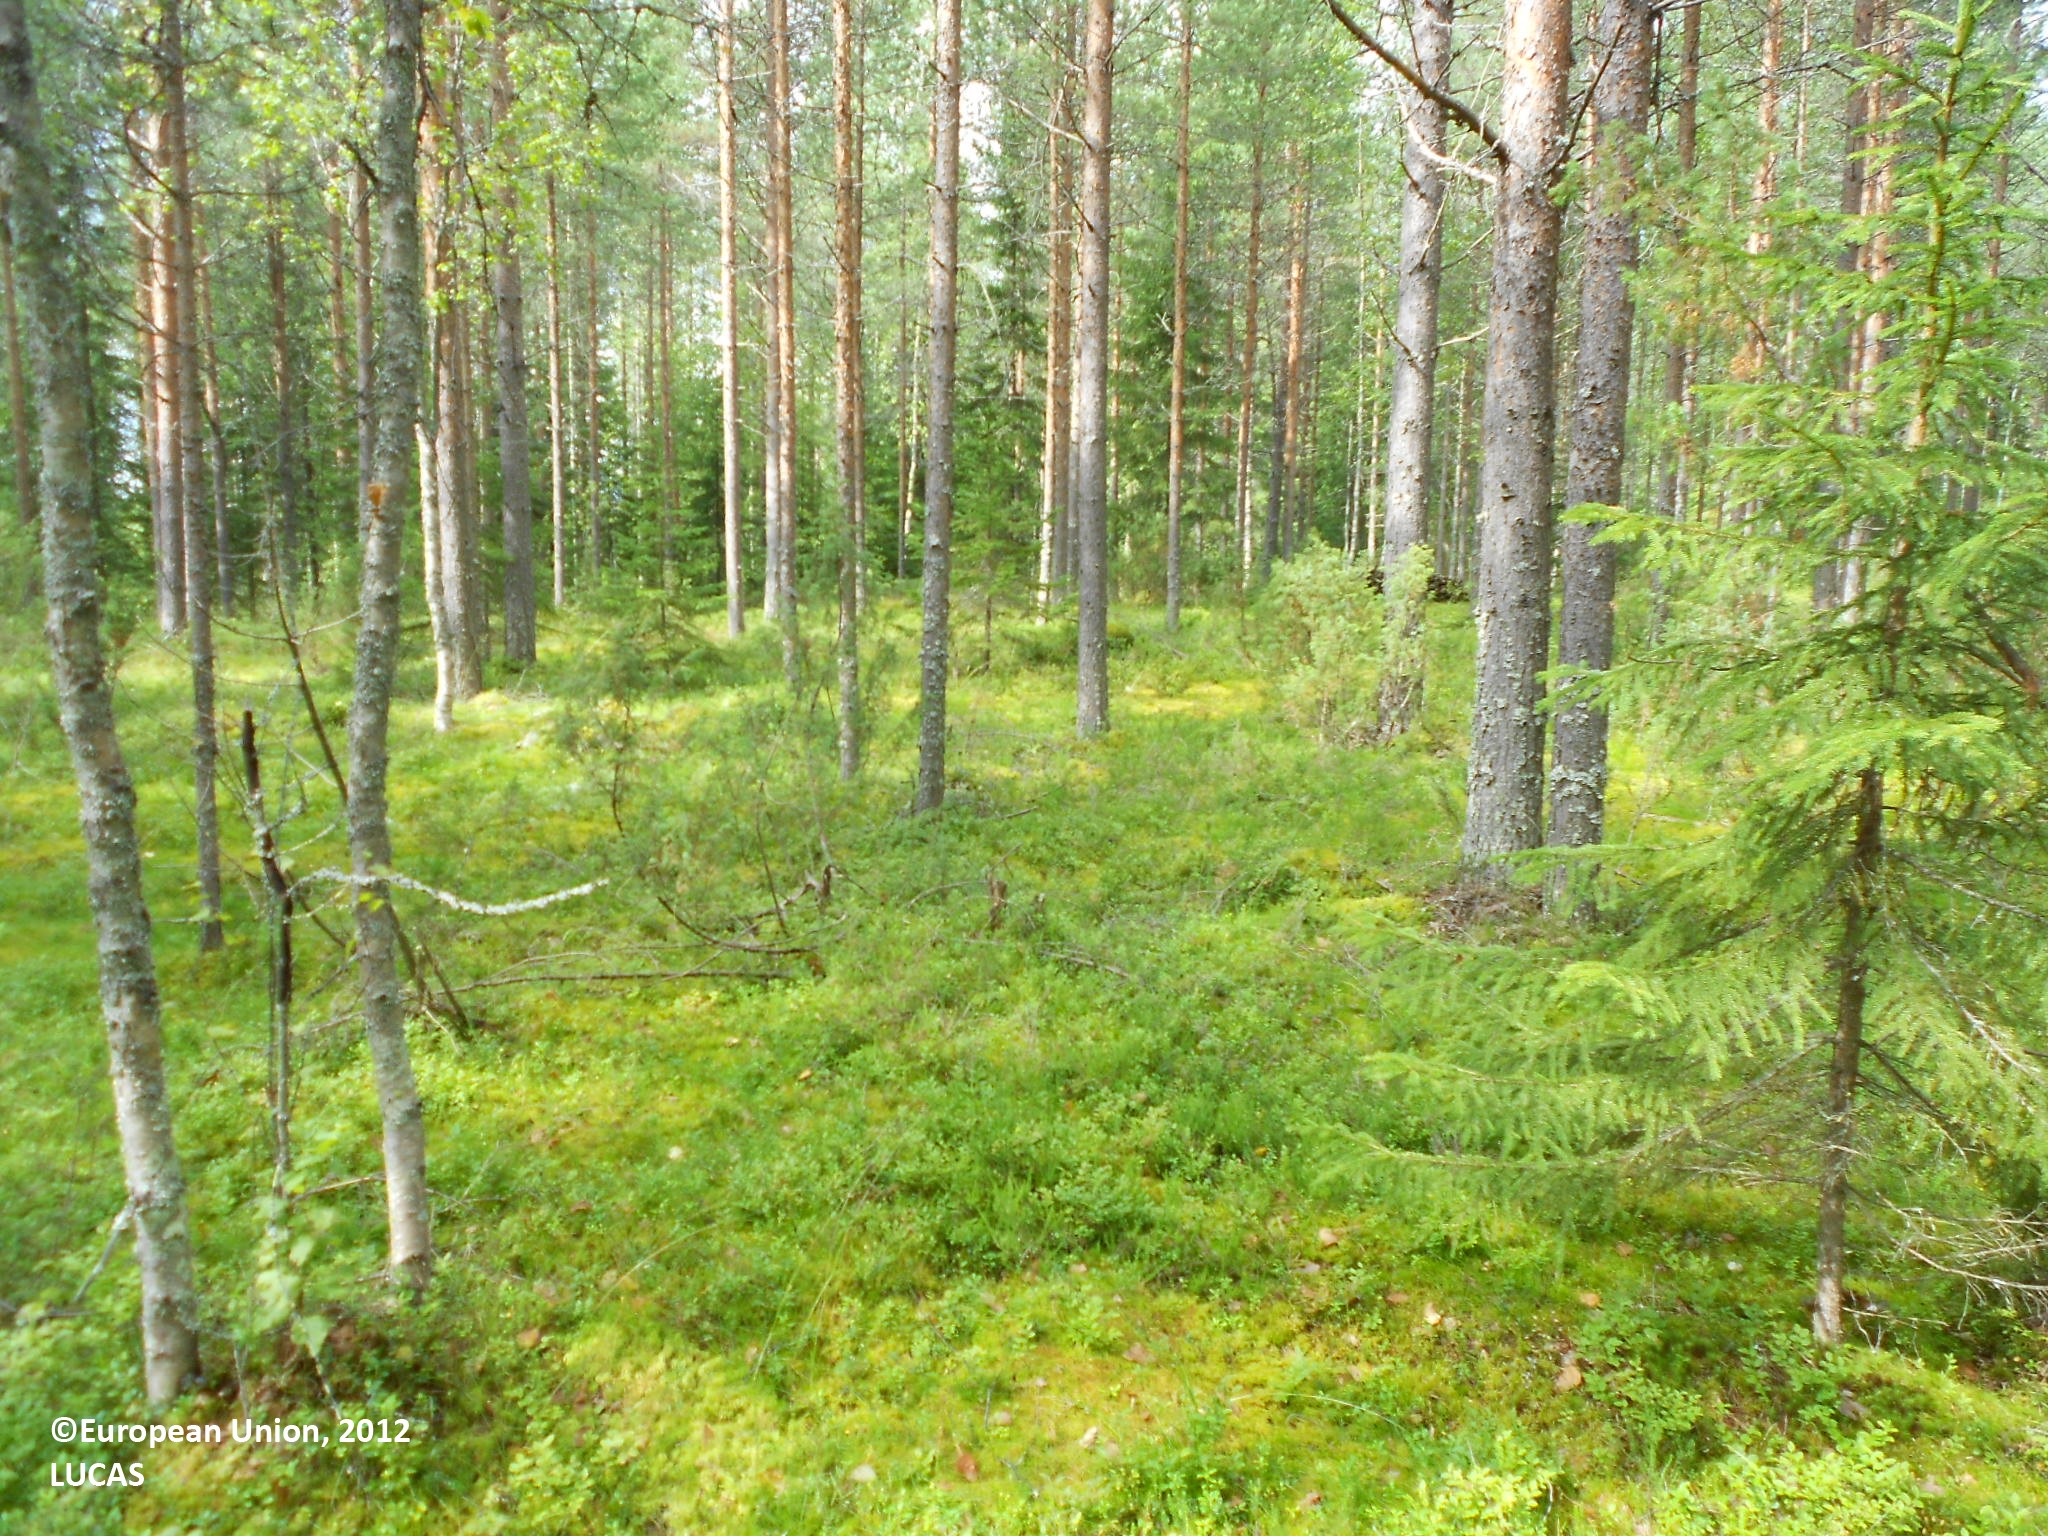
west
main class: Woodland
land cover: Pine dominated coniferous woodland
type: boreal forest
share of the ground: 50 - 75 %
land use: Forestry
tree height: > 5 m
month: August
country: FI
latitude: 63.6154
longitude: 28.3133
